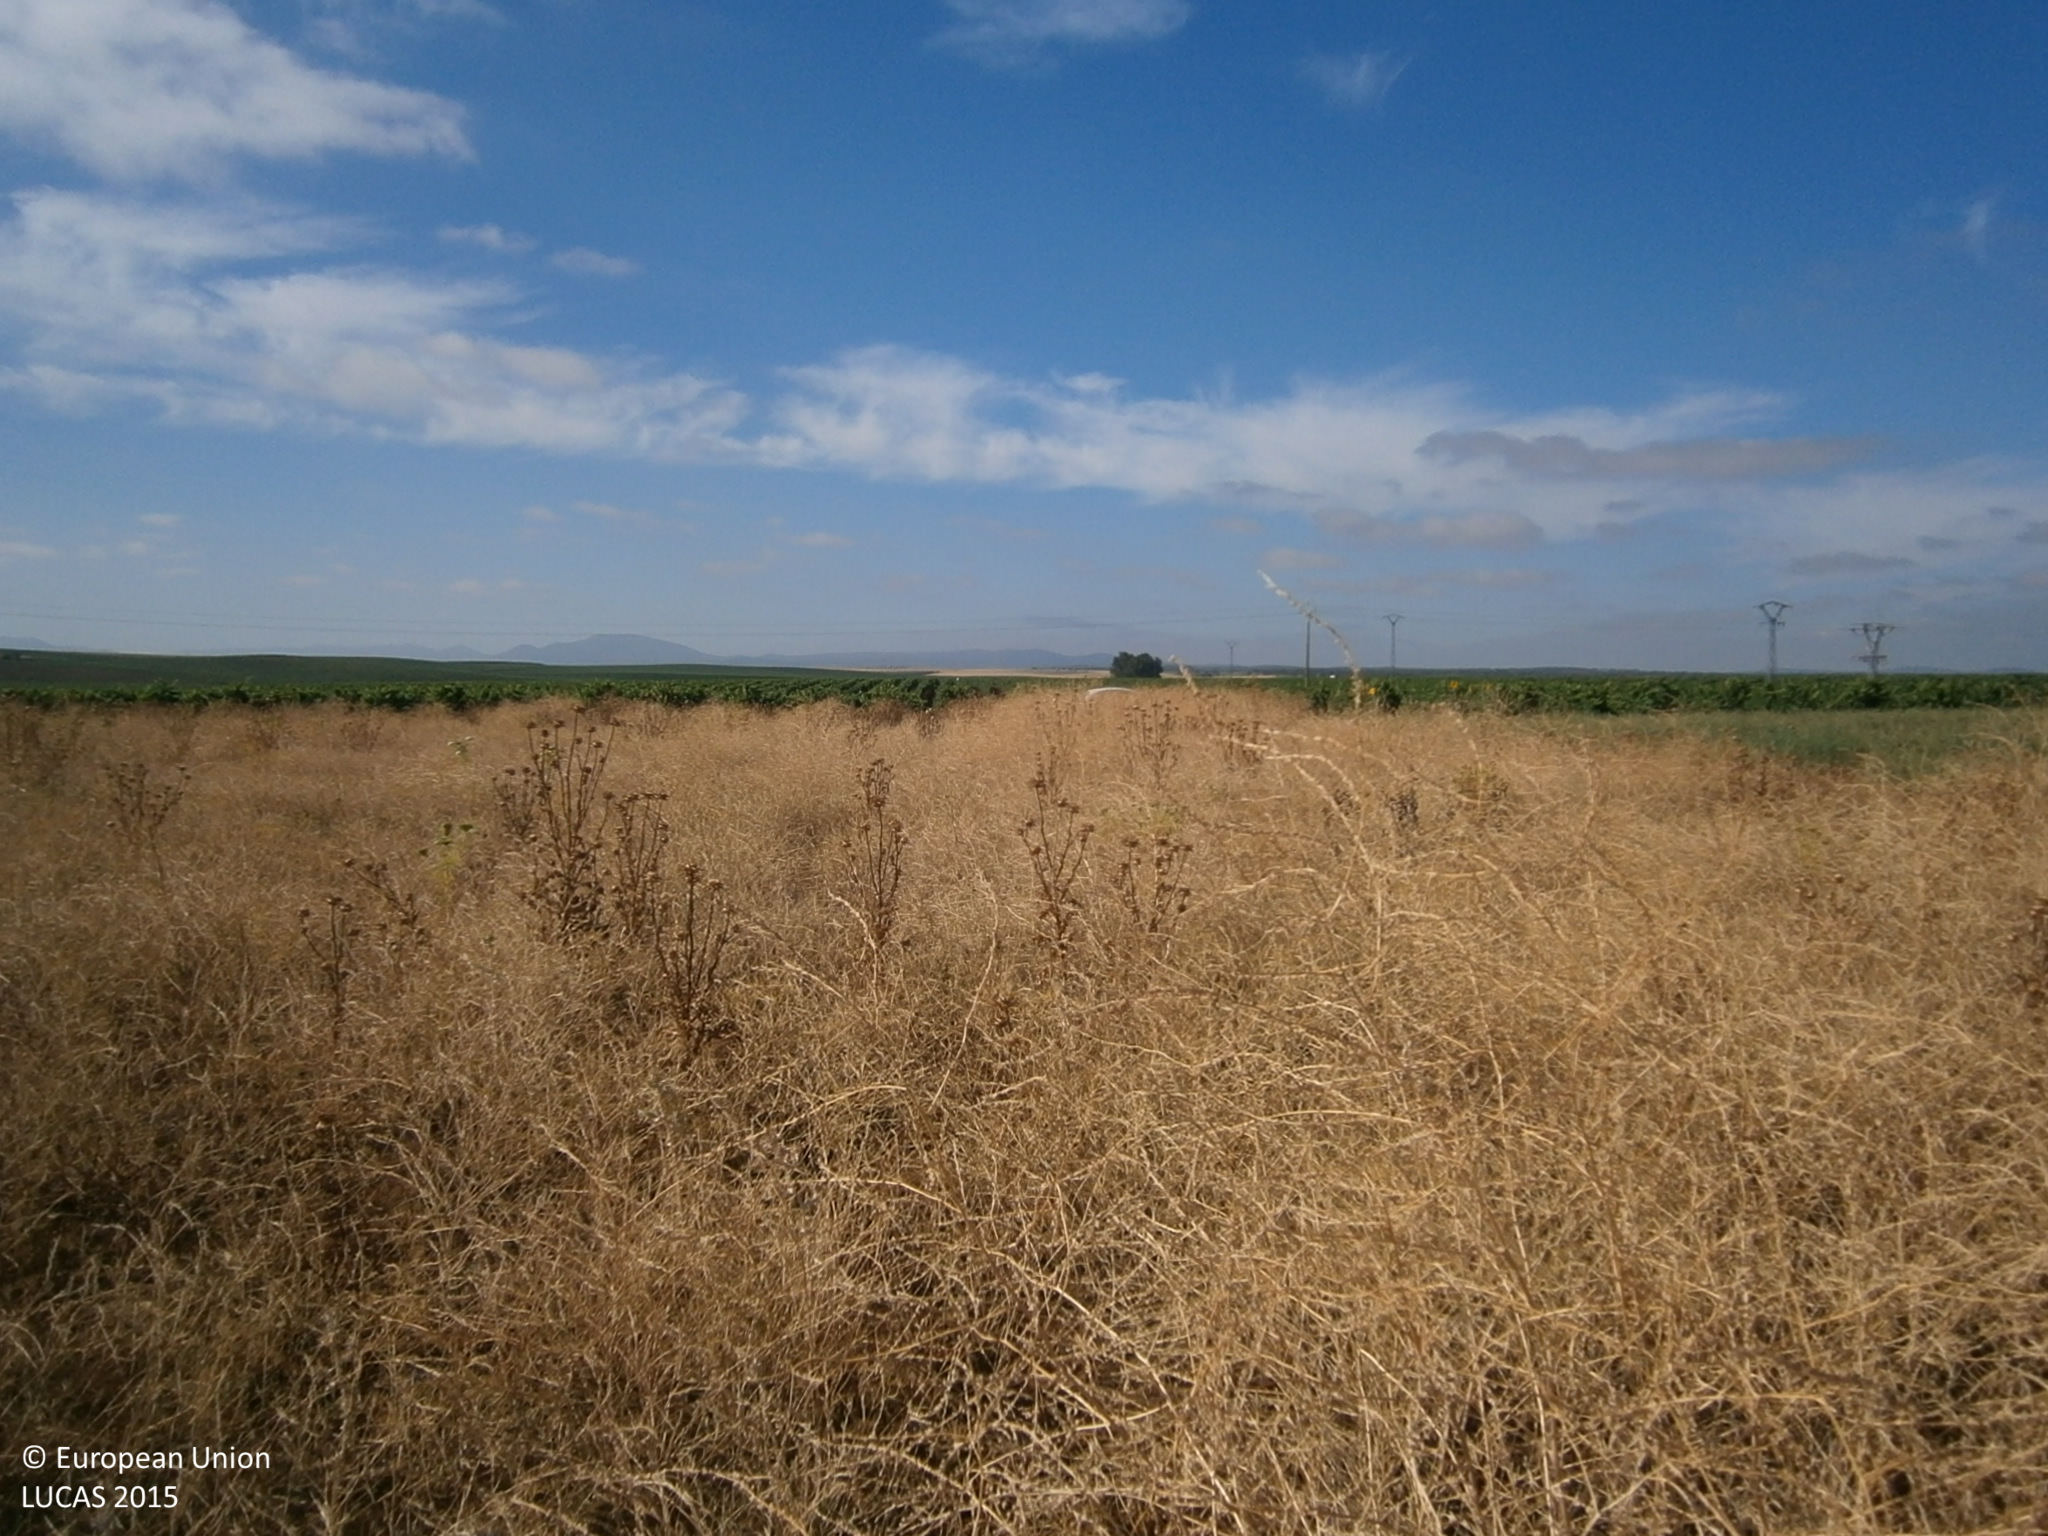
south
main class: Grassland
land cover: Spontaneously vegetated surfaces
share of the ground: > 75 %
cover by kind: herbaceous plants 95 %, unconsolidated bare surface 5 %
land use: Fallow land
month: June
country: ES
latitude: 38.7073
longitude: -6.8417
